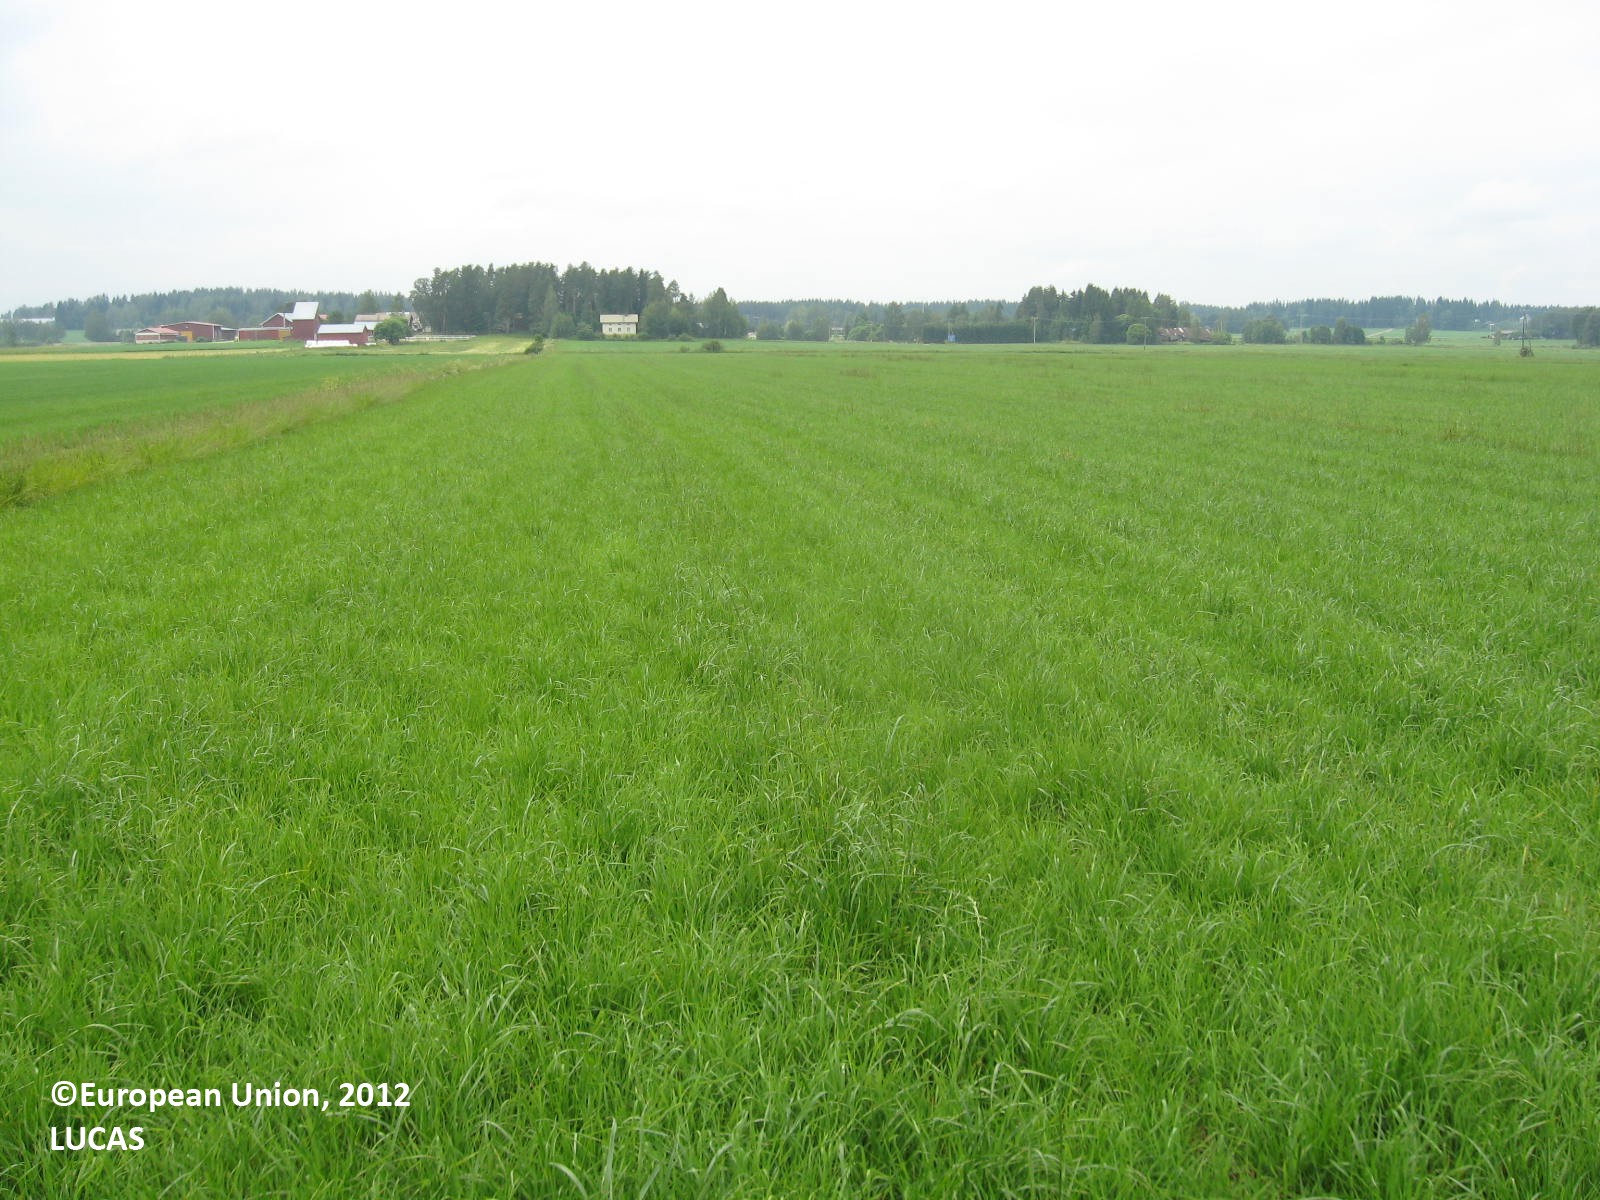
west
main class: Cropland
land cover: Temporary grasslands
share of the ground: > 75 %
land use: Agriculture (excluding fallow land and kitchen gardens)
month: July
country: FI
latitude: 62.4485
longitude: 22.7924
